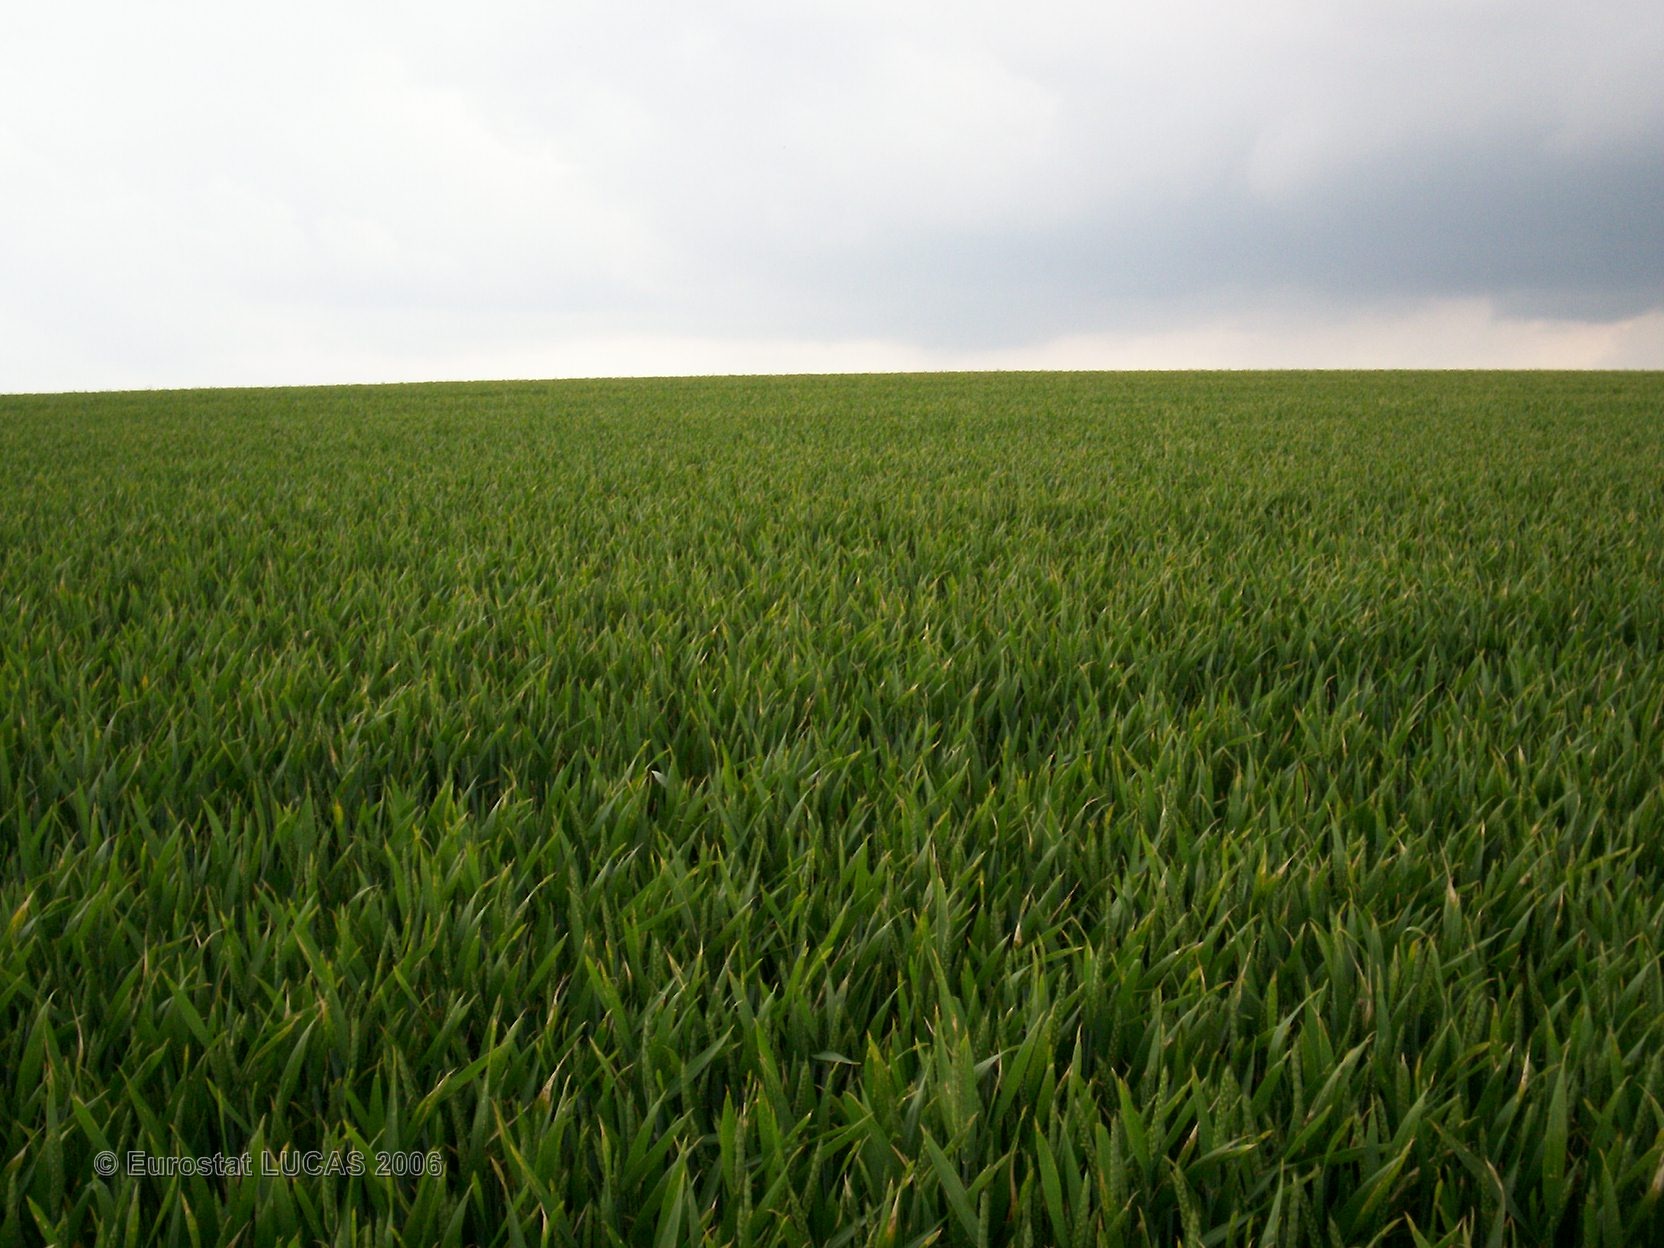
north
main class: Cropland
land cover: Common wheat
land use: Agriculture (excluding fallow land and kitchen gardens)
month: June
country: FR
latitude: 48.6619
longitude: 4.4711
